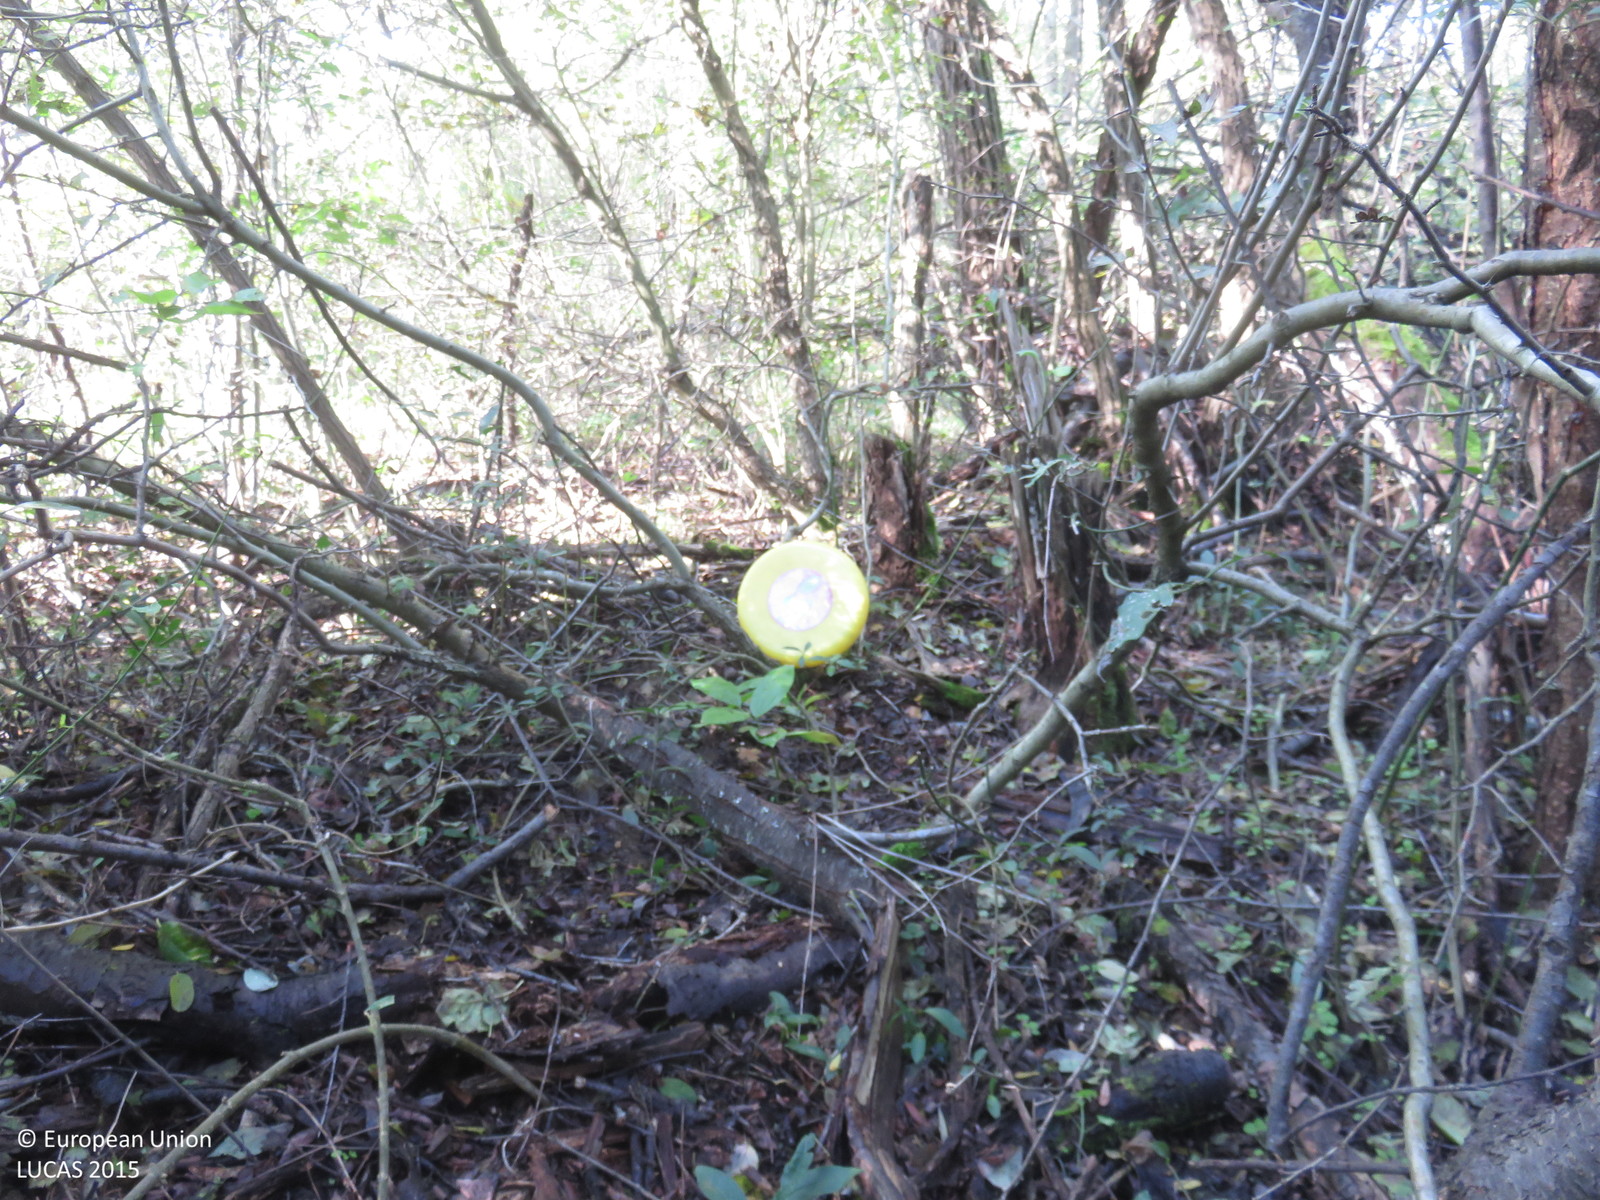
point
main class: Woodland
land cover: Broadleaved woodland
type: mesophytic deciduous forest
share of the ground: > 75 %
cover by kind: broadleaved forest trees 90 %, shrubs 10 %
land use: Forestry
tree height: < 5 m
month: October
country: BG
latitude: 42.9263
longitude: 25.1003
